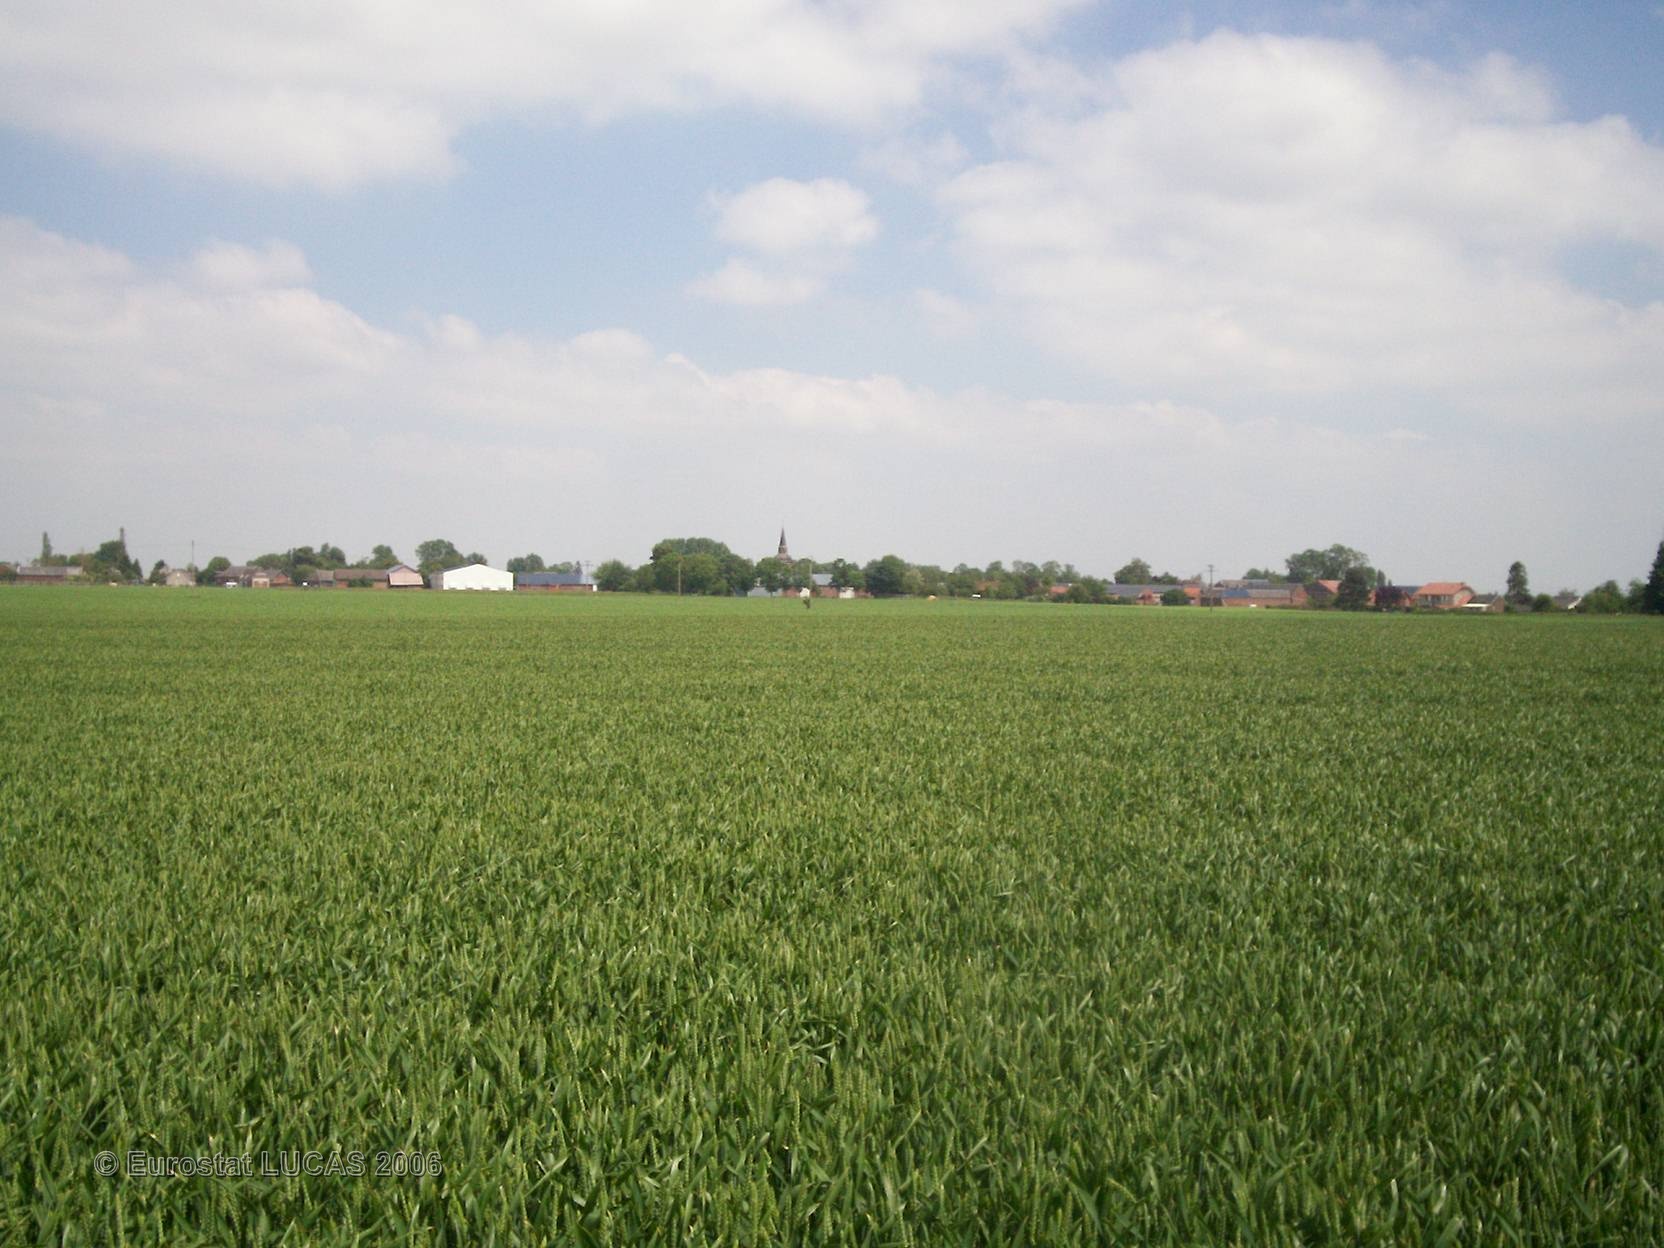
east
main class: Cropland
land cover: Common wheat
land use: Agriculture (excluding fallow land and kitchen gardens)
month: June
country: FR
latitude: 49.7695
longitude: 2.6994
